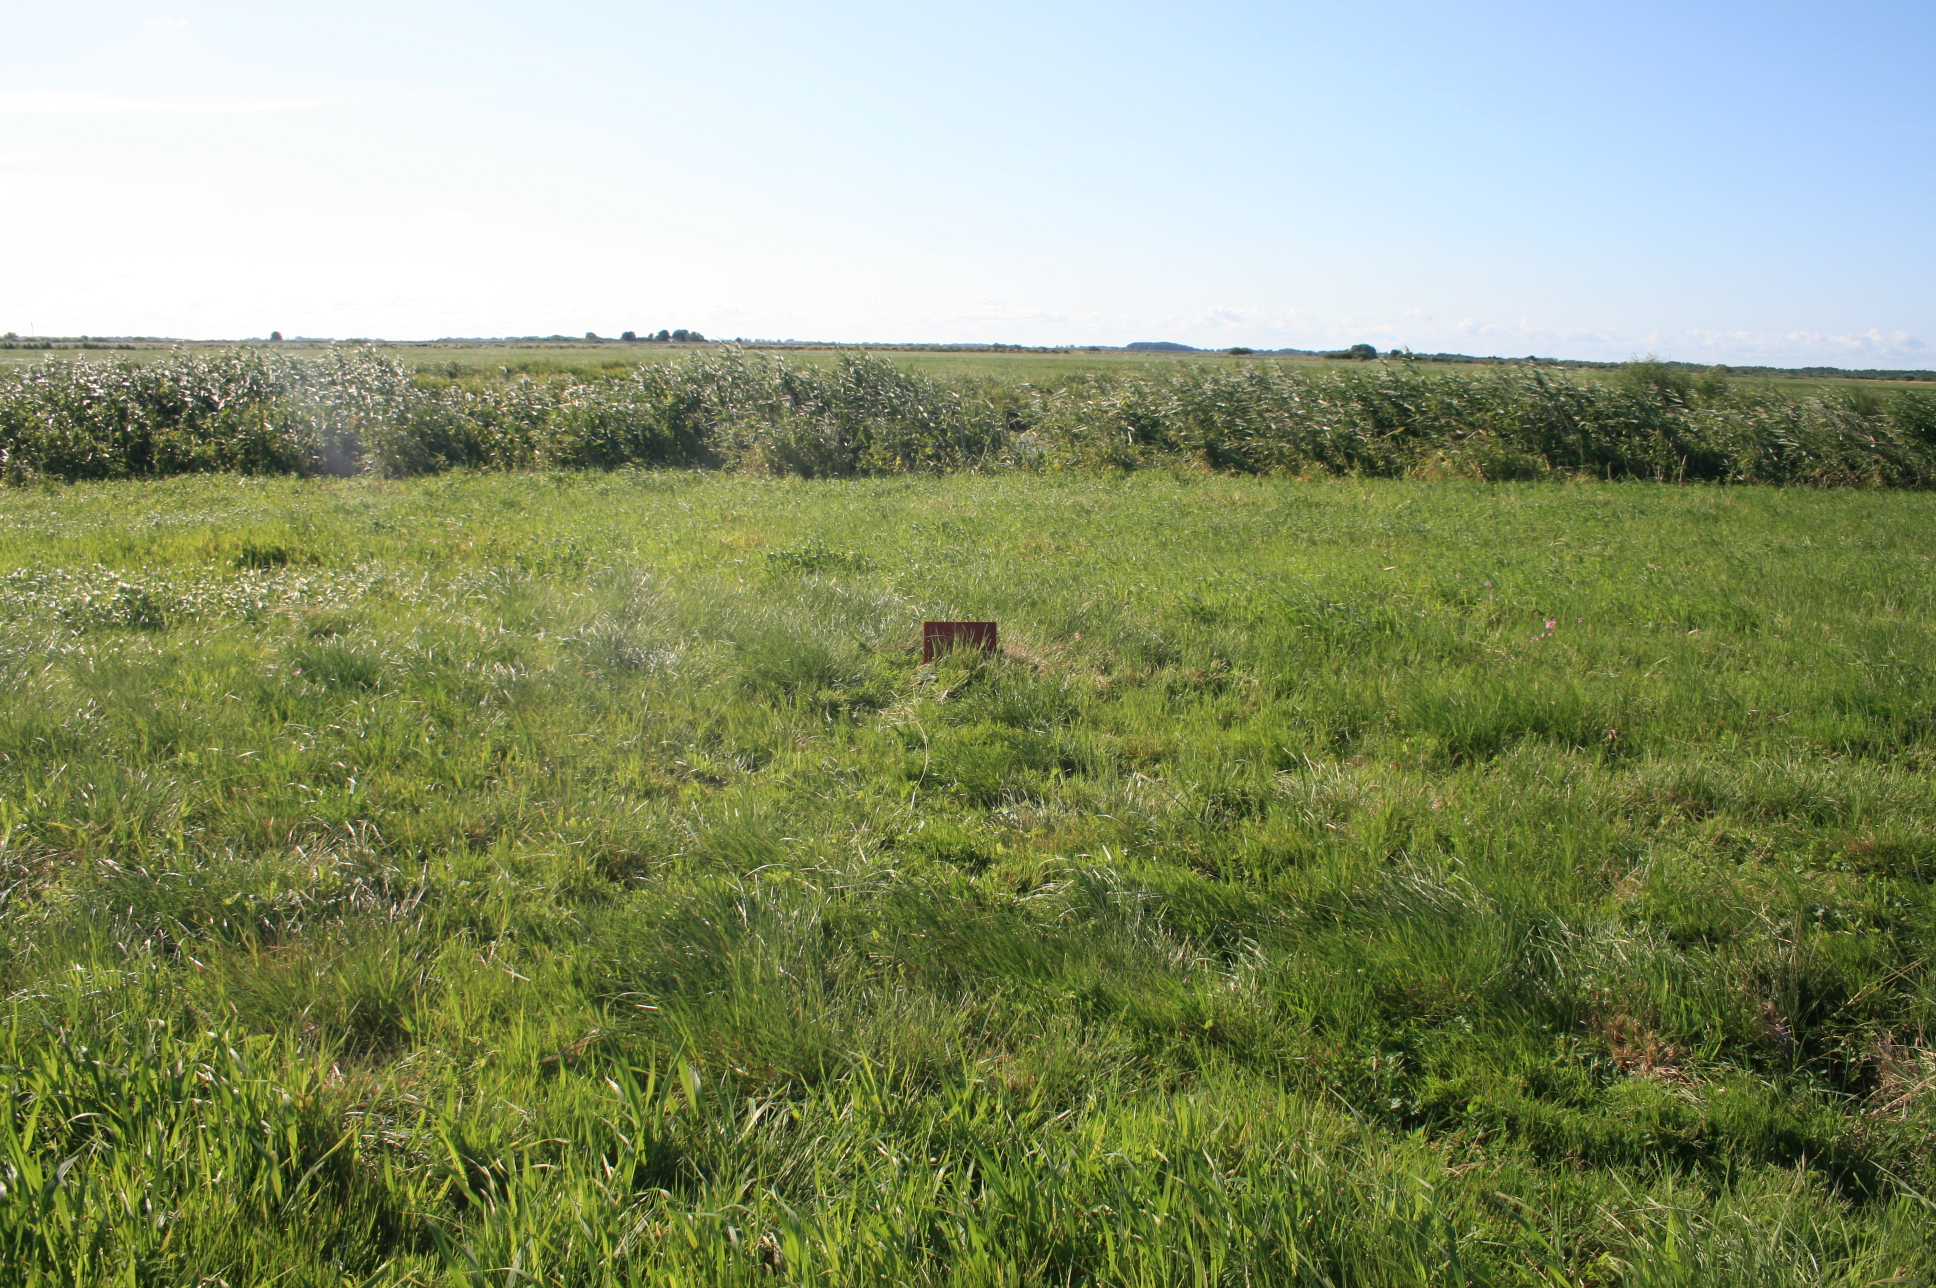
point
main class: Grassland
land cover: Grassland without tree/shrub cover
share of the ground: > 75 %
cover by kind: herbaceous plants 100 %
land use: Agriculture (excluding fallow land and kitchen gardens)
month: July
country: LT
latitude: 55.3783
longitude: 21.2960
